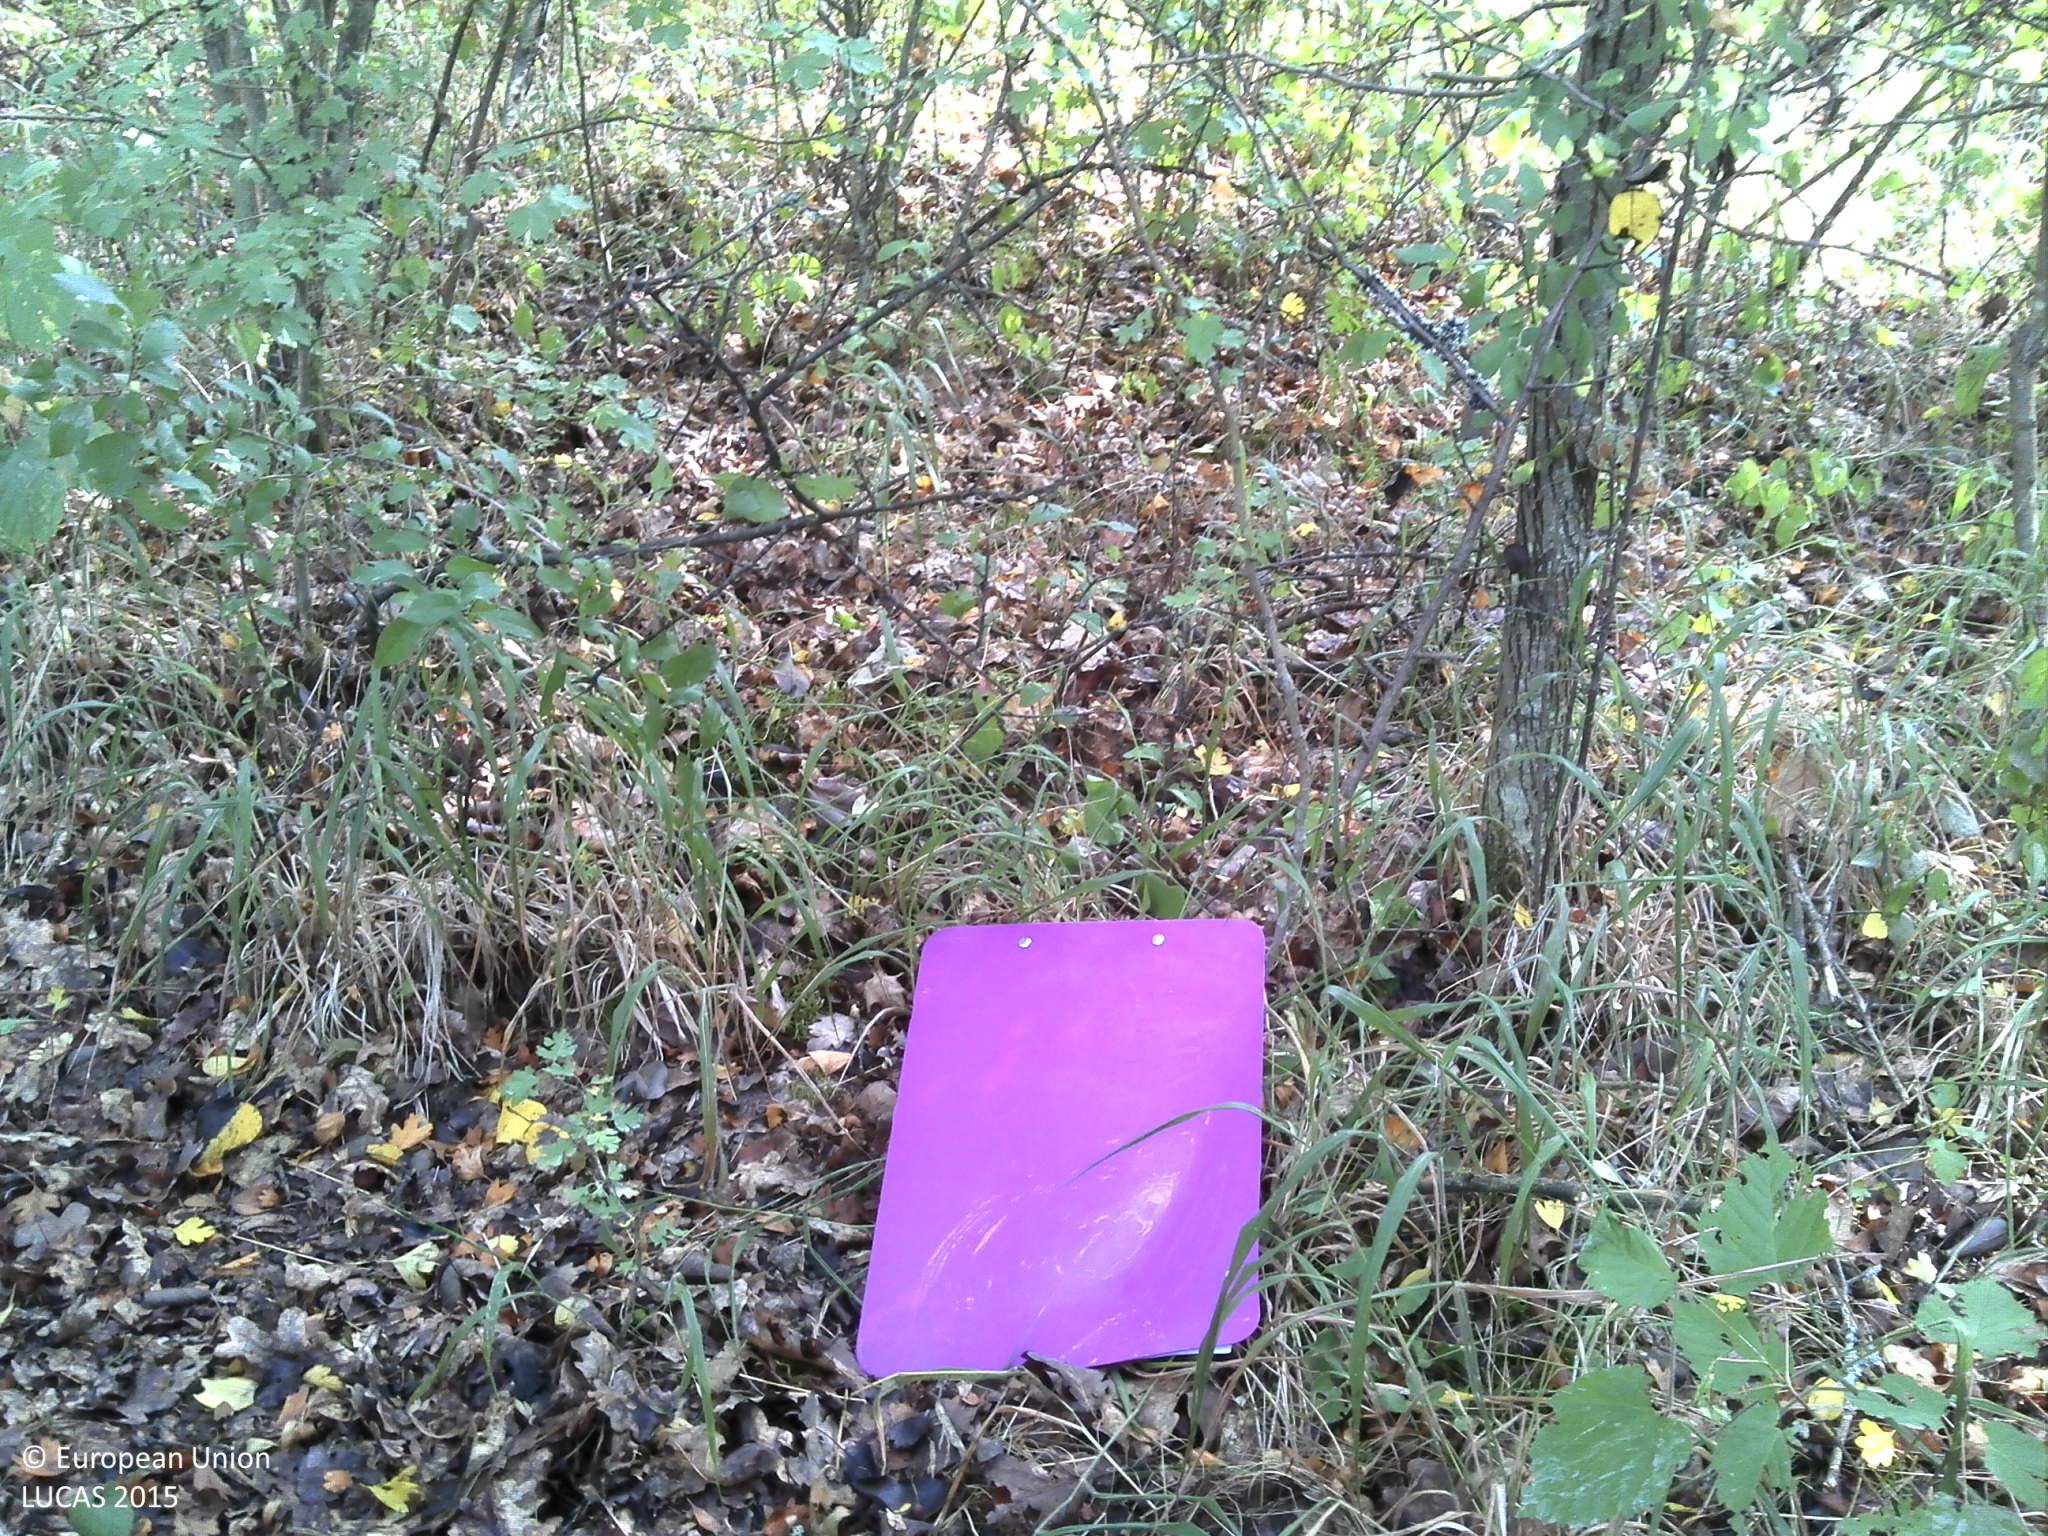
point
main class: Shrubland
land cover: Shrubland with sparse tree cover
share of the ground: > 75 %
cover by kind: shrubs 95 %, broadleaved forest trees 5 %
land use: Semi-natural and natural areas not in use
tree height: < 5 m
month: August
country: HR
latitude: 45.2935
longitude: 18.2029
